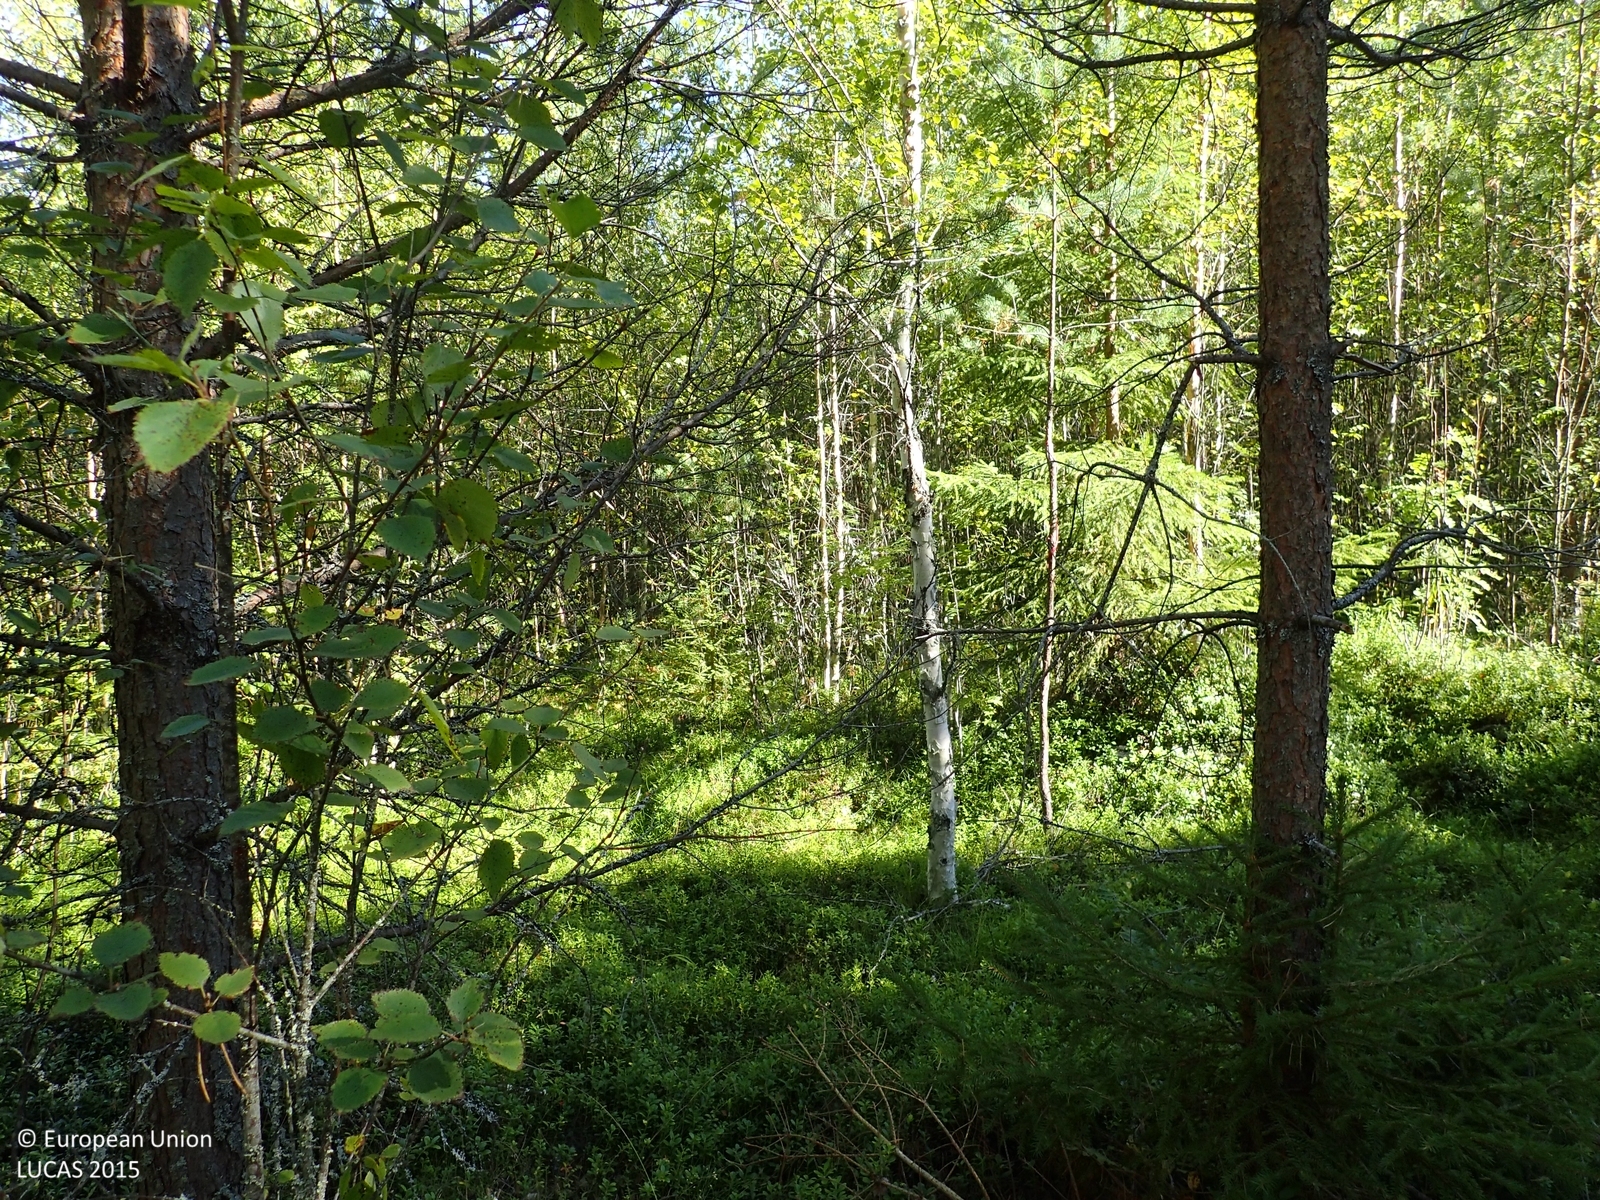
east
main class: Woodland
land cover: Pine dominated mixed woodland
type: boreal forest
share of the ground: > 75 %
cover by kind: broadleaved forest trees 40 %, coniferous forest trees 35 %, shrubs 10 %, herbaceous plants 10 %, lichens and mosses 5 %
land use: Forestry
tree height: > 5 m
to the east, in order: Pine dominated mixed woodland; Broadleaved woodland; Spruce dominated mixed woodland; Pine dominated mixed woodland; Spruce dominated mixed woodland; Ditches and canals; Spruce dominated mixed woodland; Broadleaved woodland
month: August
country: FI
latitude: 62.5885
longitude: 22.6544
